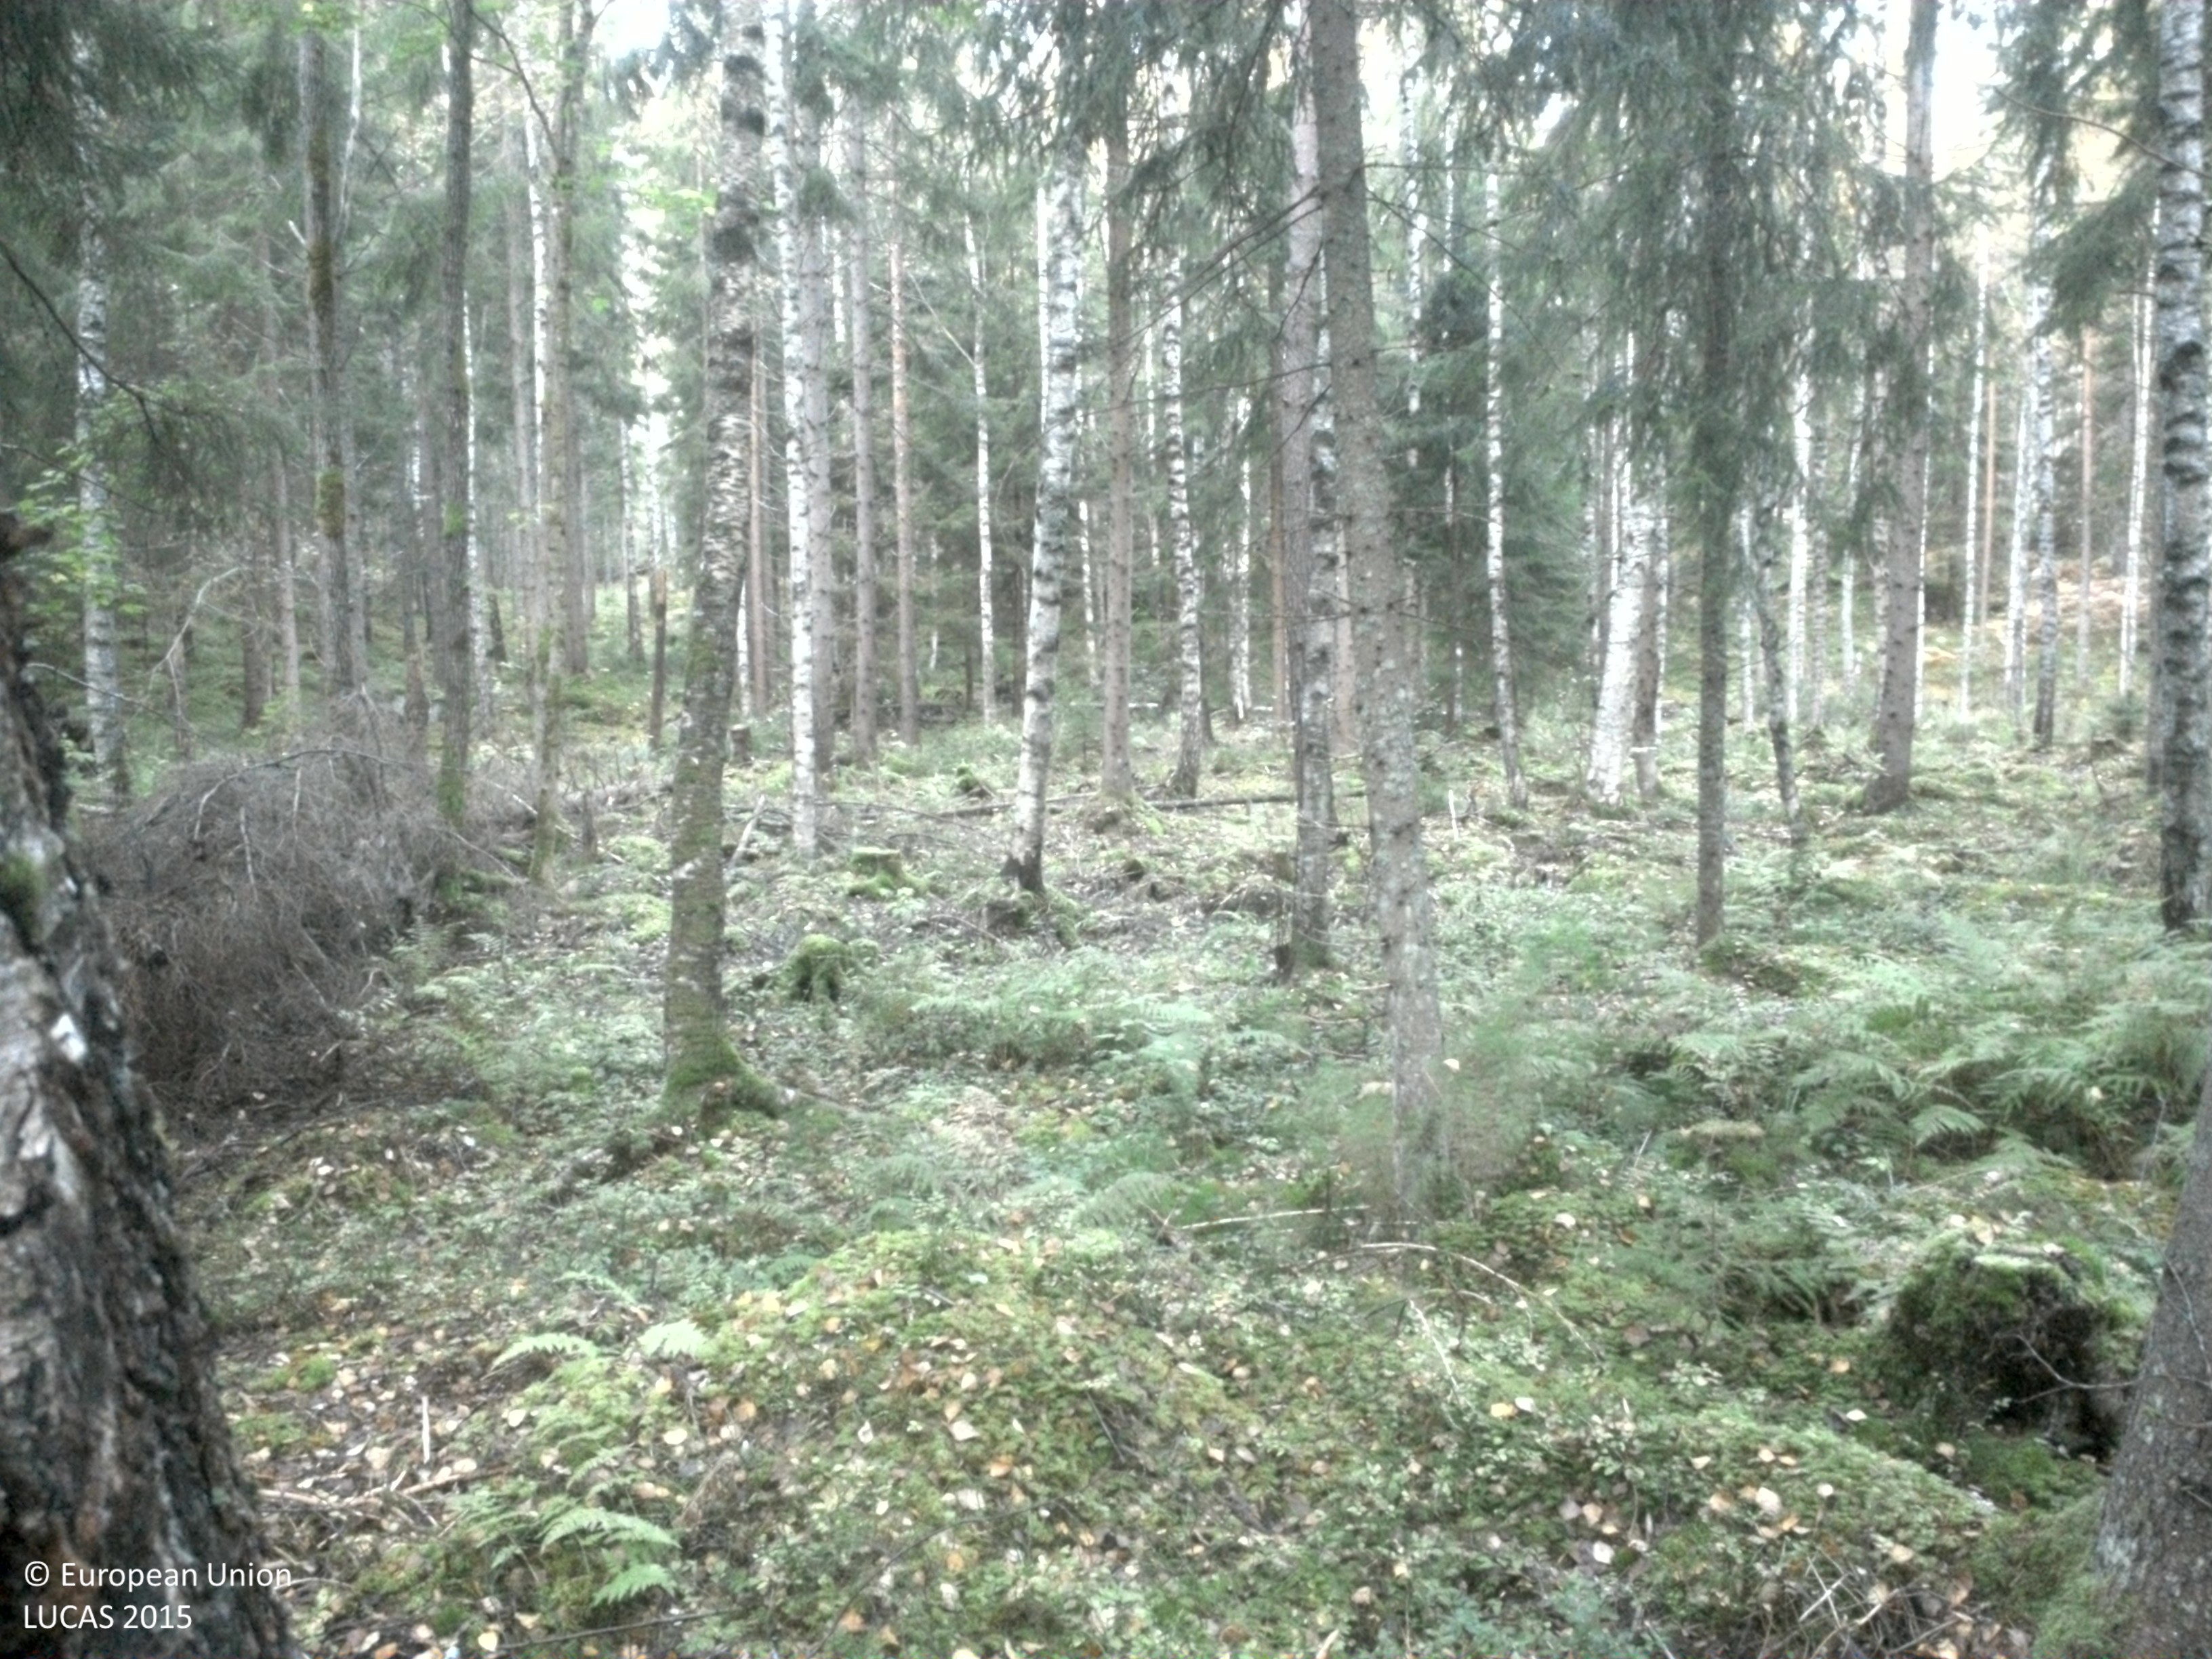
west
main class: Woodland
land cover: Spruce dominated mixed woodland
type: boreal forest
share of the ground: 50 - 75 %
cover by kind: coniferous forest trees 40 %, broadleaved forest trees 30 %, lichens and mosses 20 %, shrubs 10 %
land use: Forestry
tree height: > 5 m
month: September
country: SE
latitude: 59.5778
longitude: 15.2491
